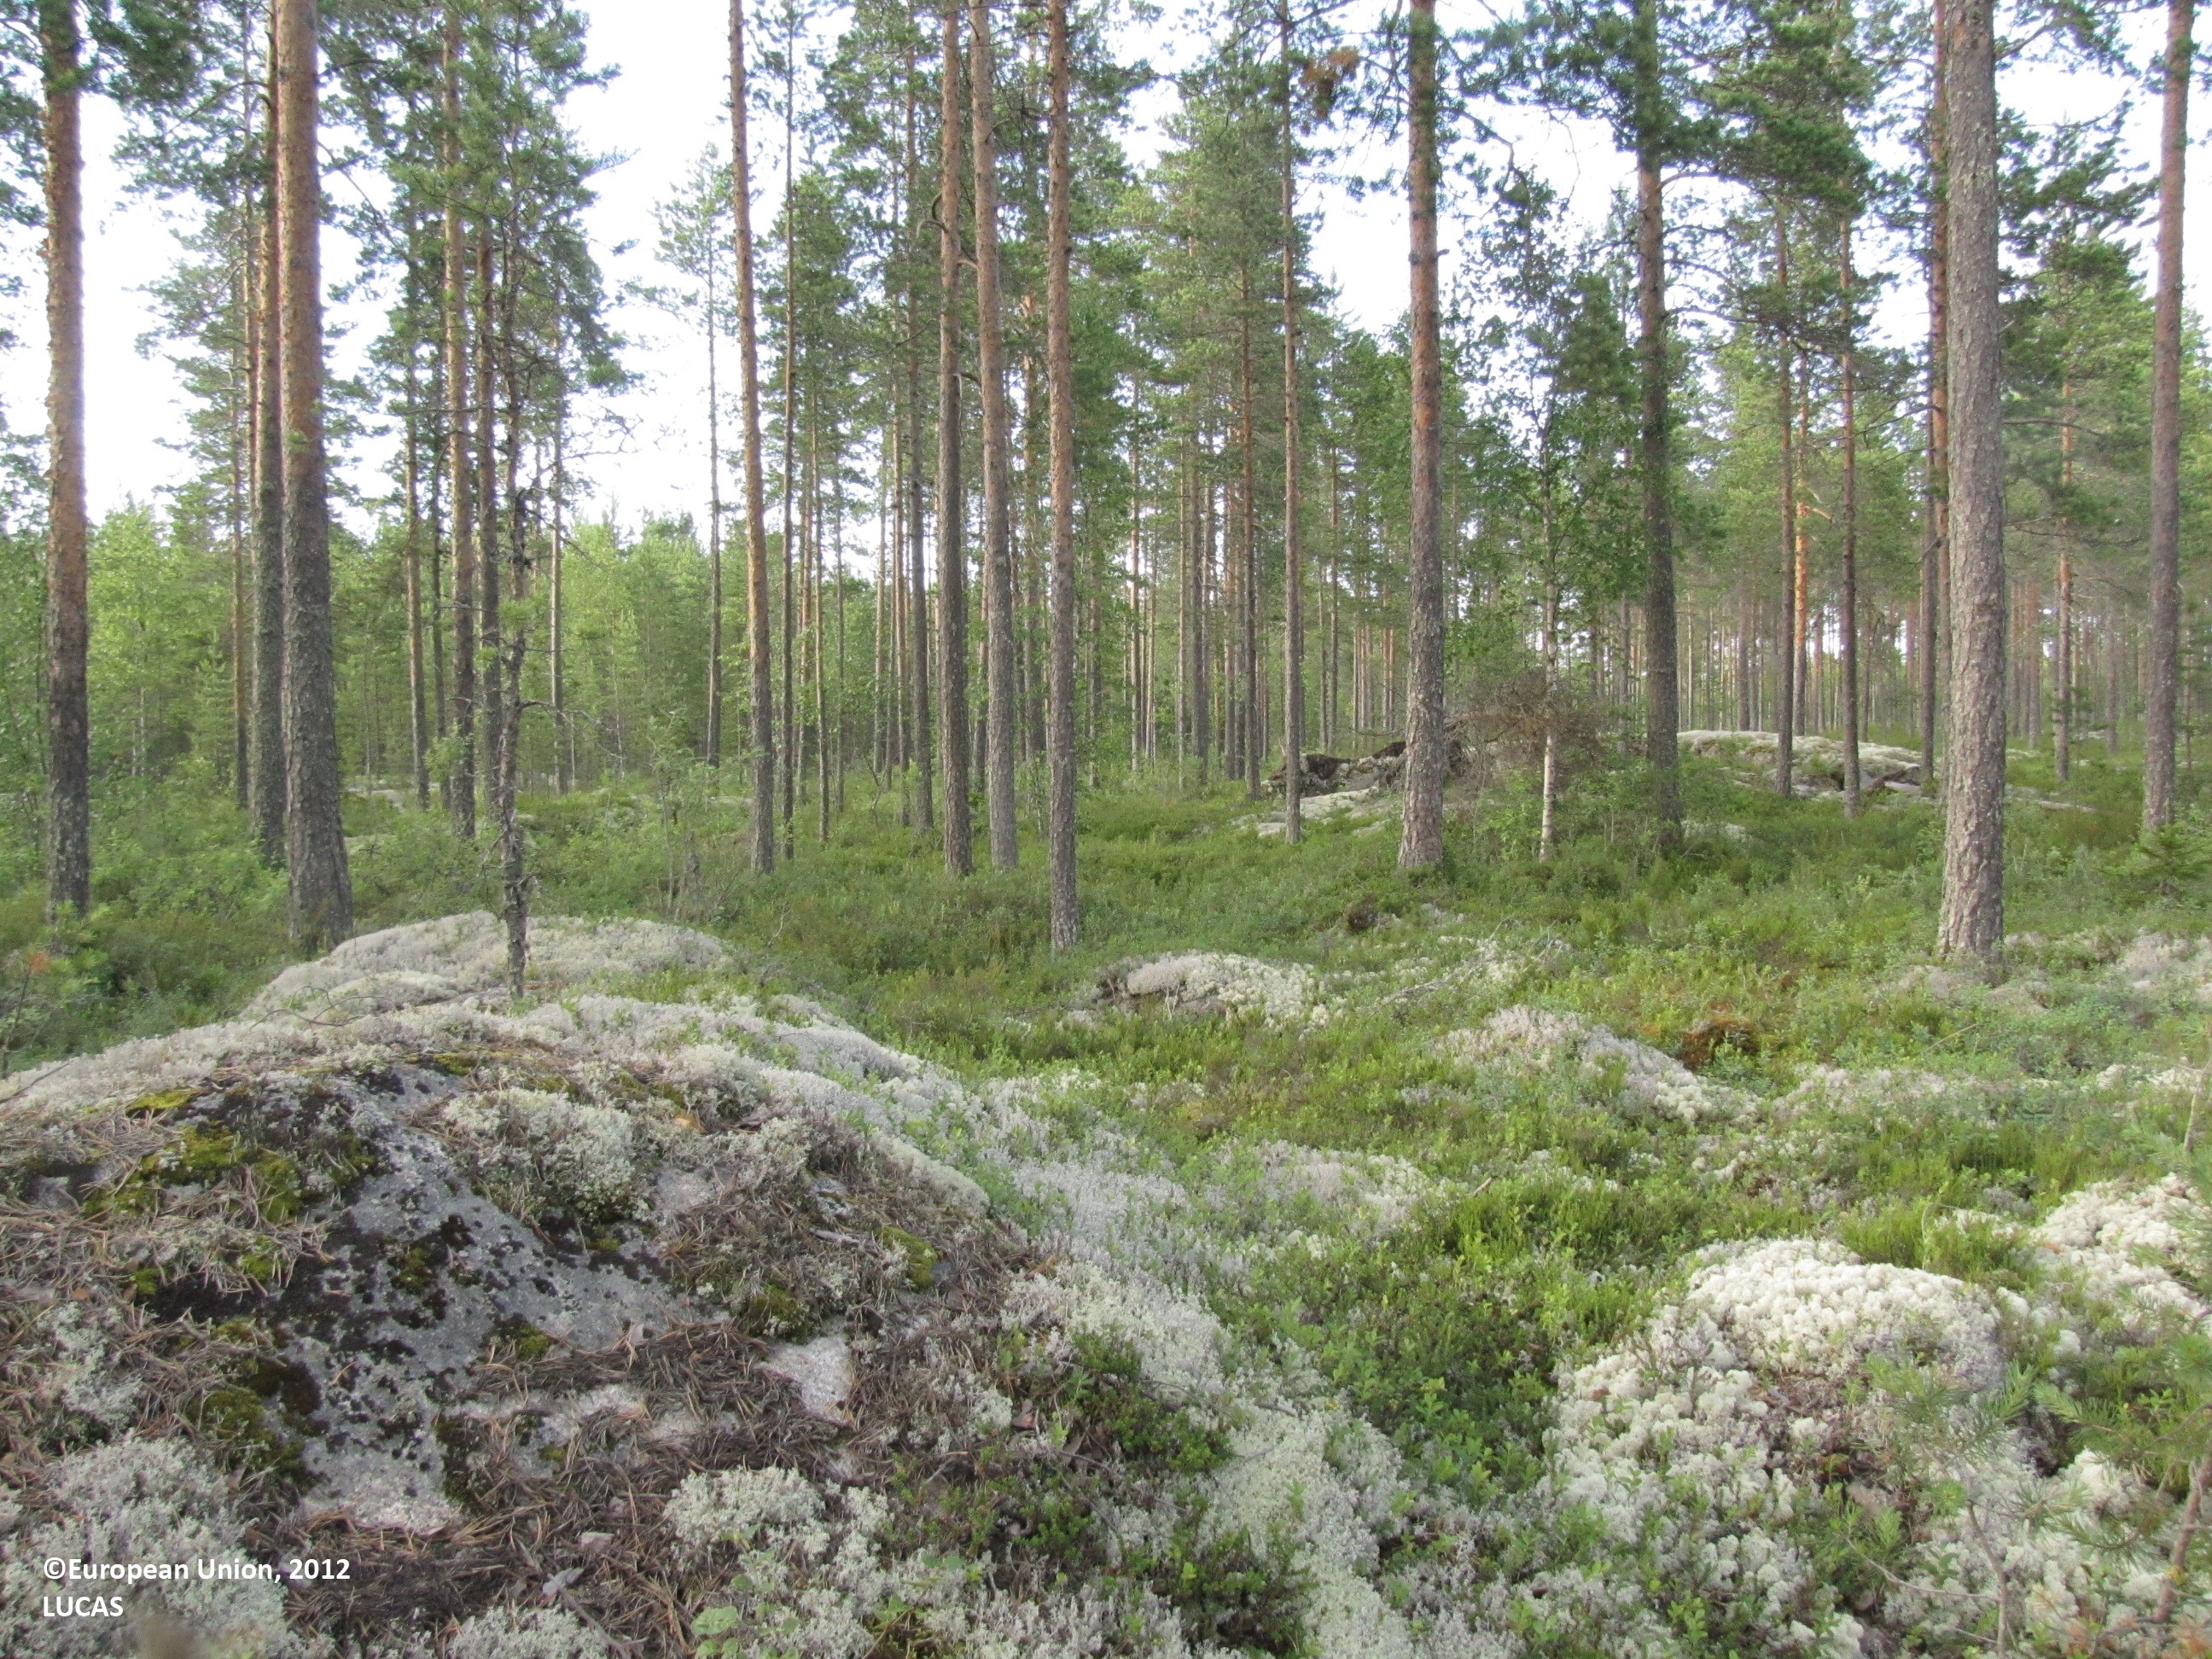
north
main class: Woodland
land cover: Pine dominated coniferous woodland
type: boreal forest
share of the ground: > 75 %
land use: Forestry
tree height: > 5 m
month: July
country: FI
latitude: 62.5259
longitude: 23.5756
